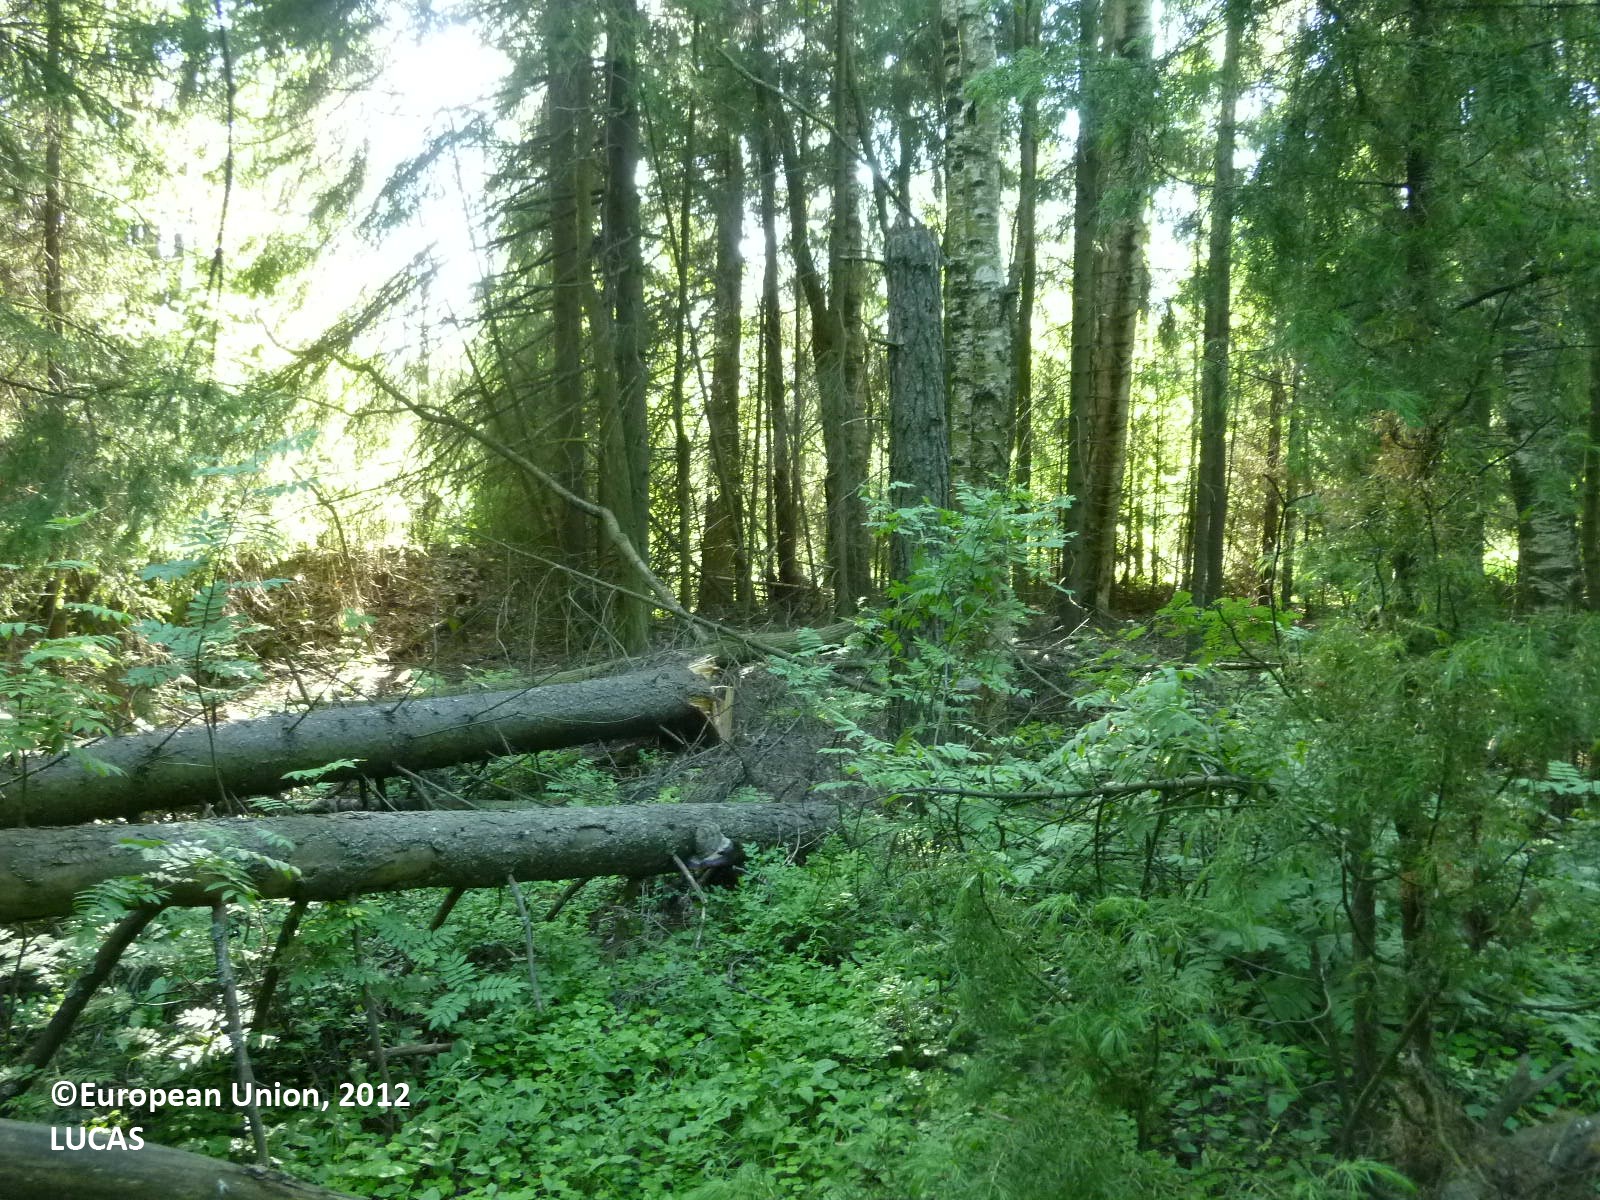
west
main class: Woodland
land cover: Broadleaved woodland
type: boreal forest
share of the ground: 50 - 75 %
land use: Forestry
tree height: > 5 m
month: July
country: FI
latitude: 61.3418
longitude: 22.0397
